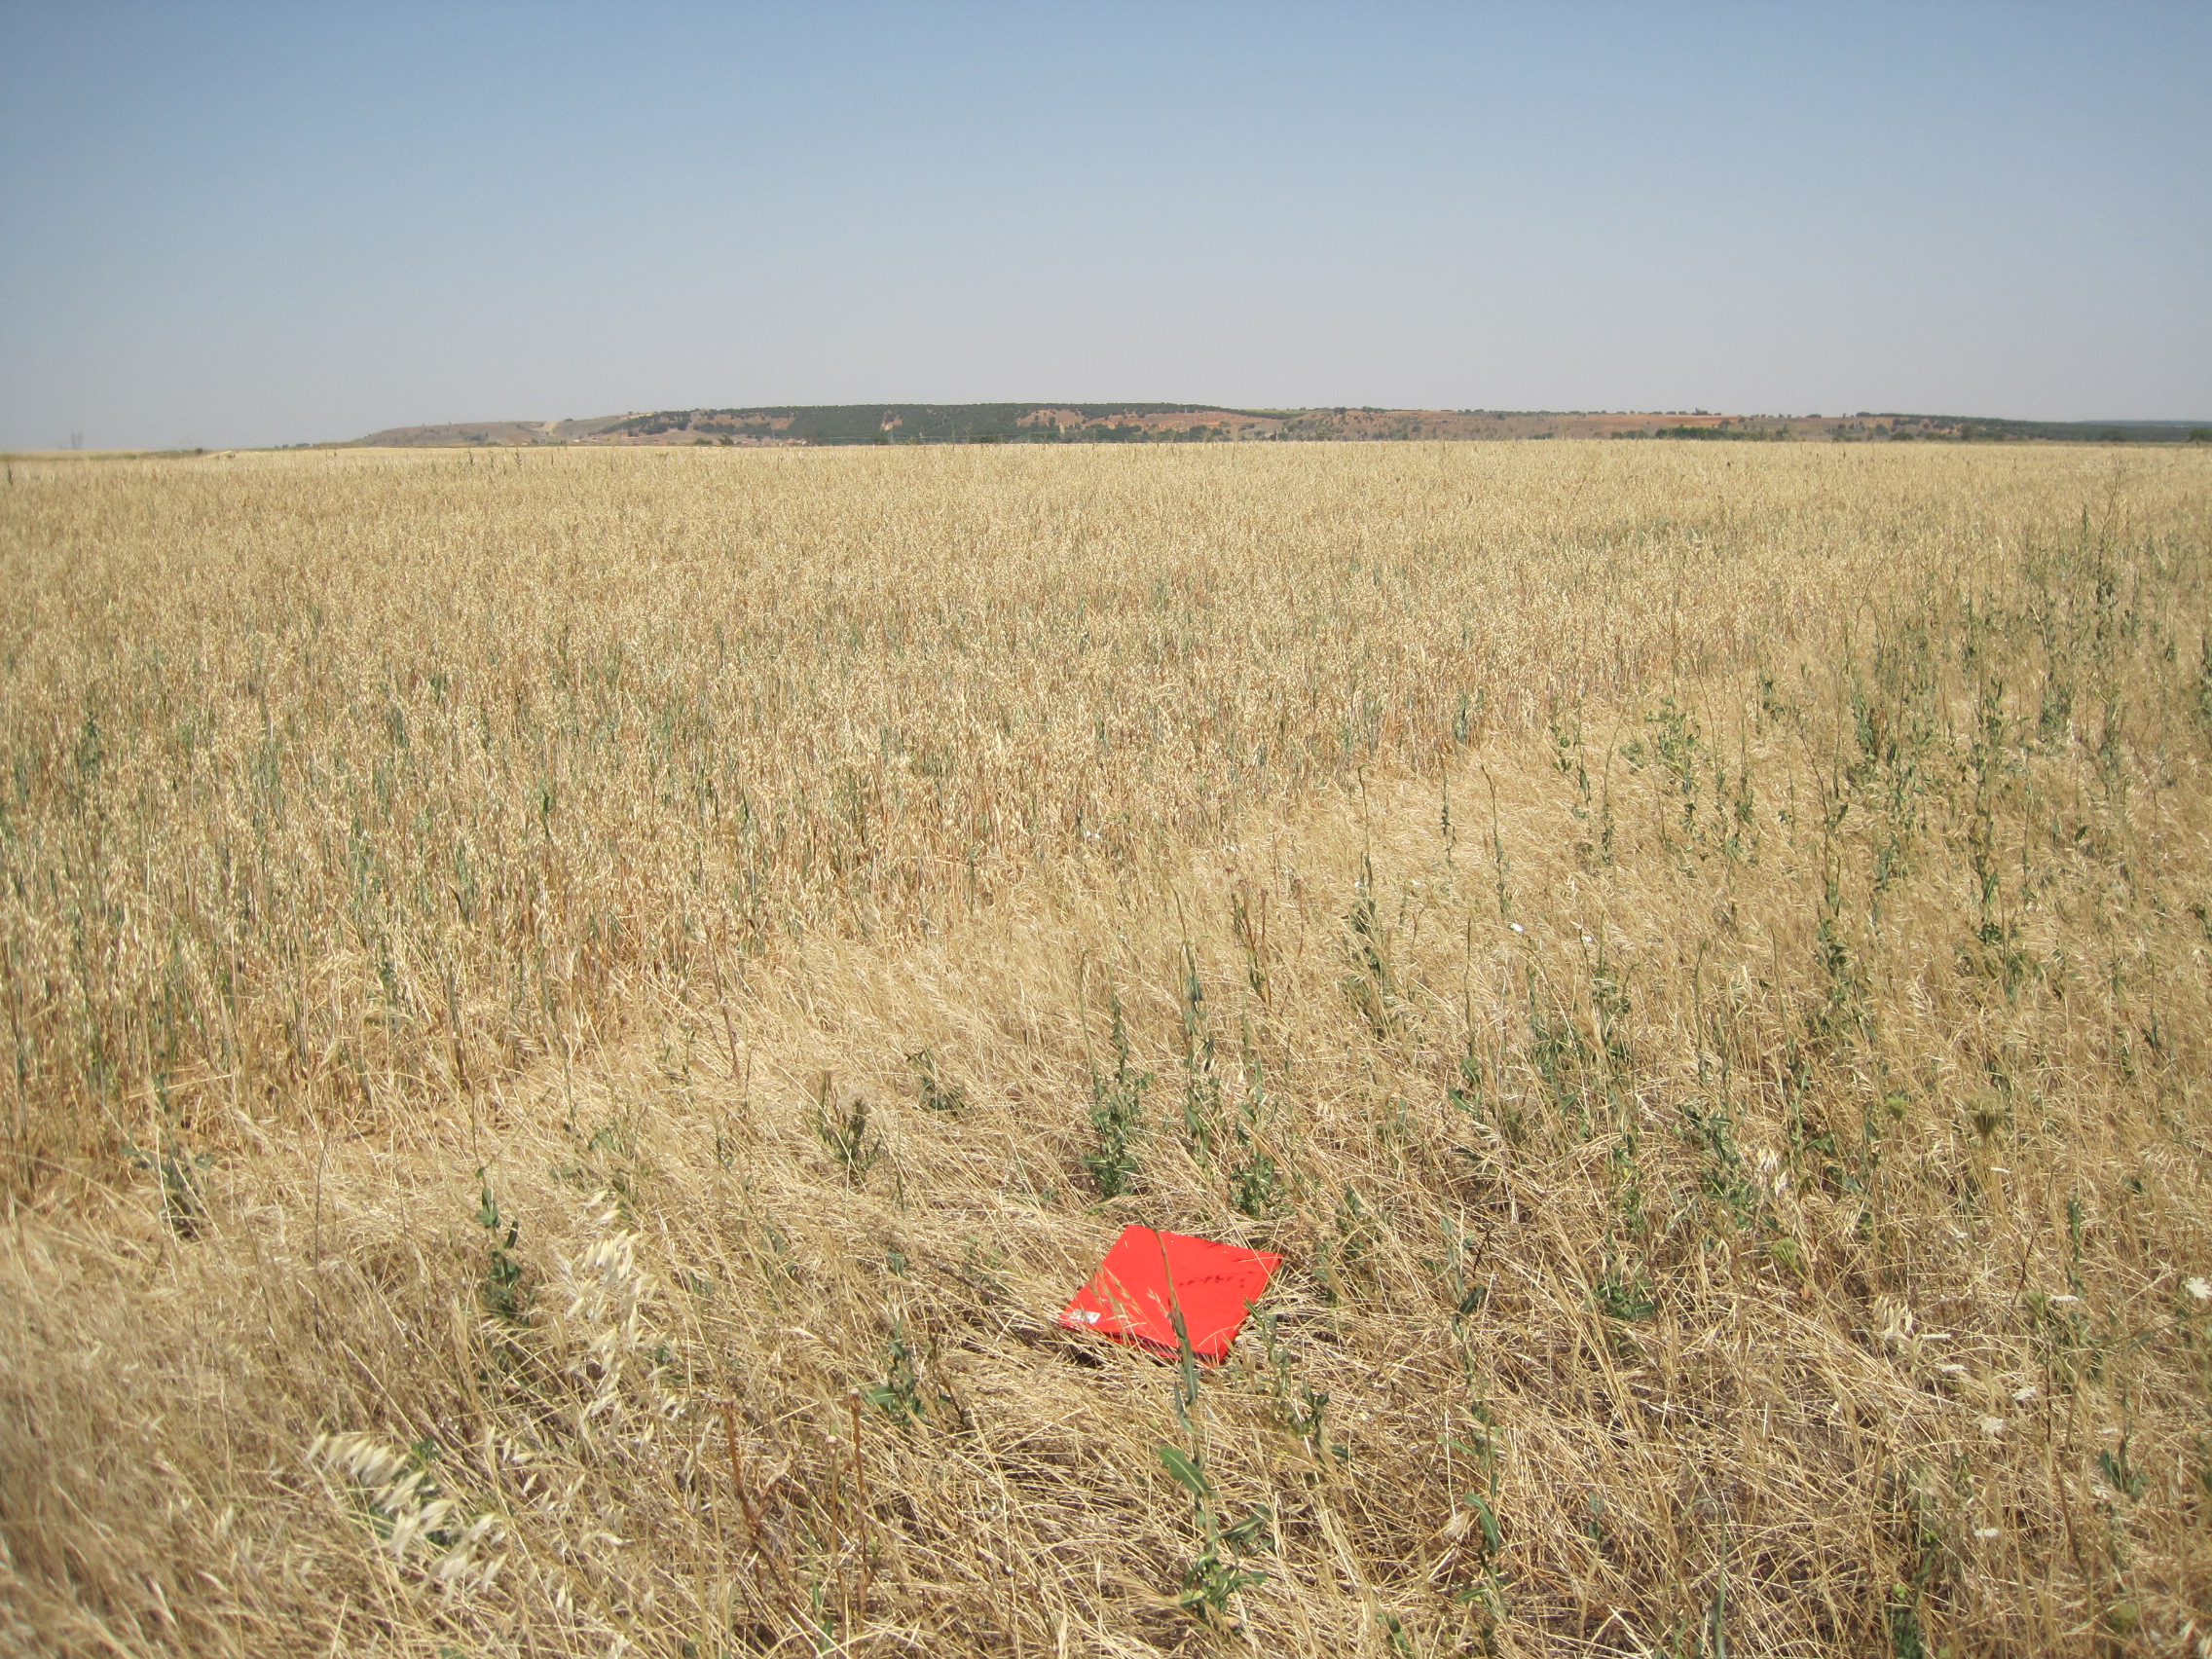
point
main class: Grassland
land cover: Spontaneously vegetated surfaces
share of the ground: > 75 %
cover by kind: herbaceous plants 100 %
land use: Abandoned areas
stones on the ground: 25 - 50 %
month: July
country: ES
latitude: 41.7023
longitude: -5.4284
